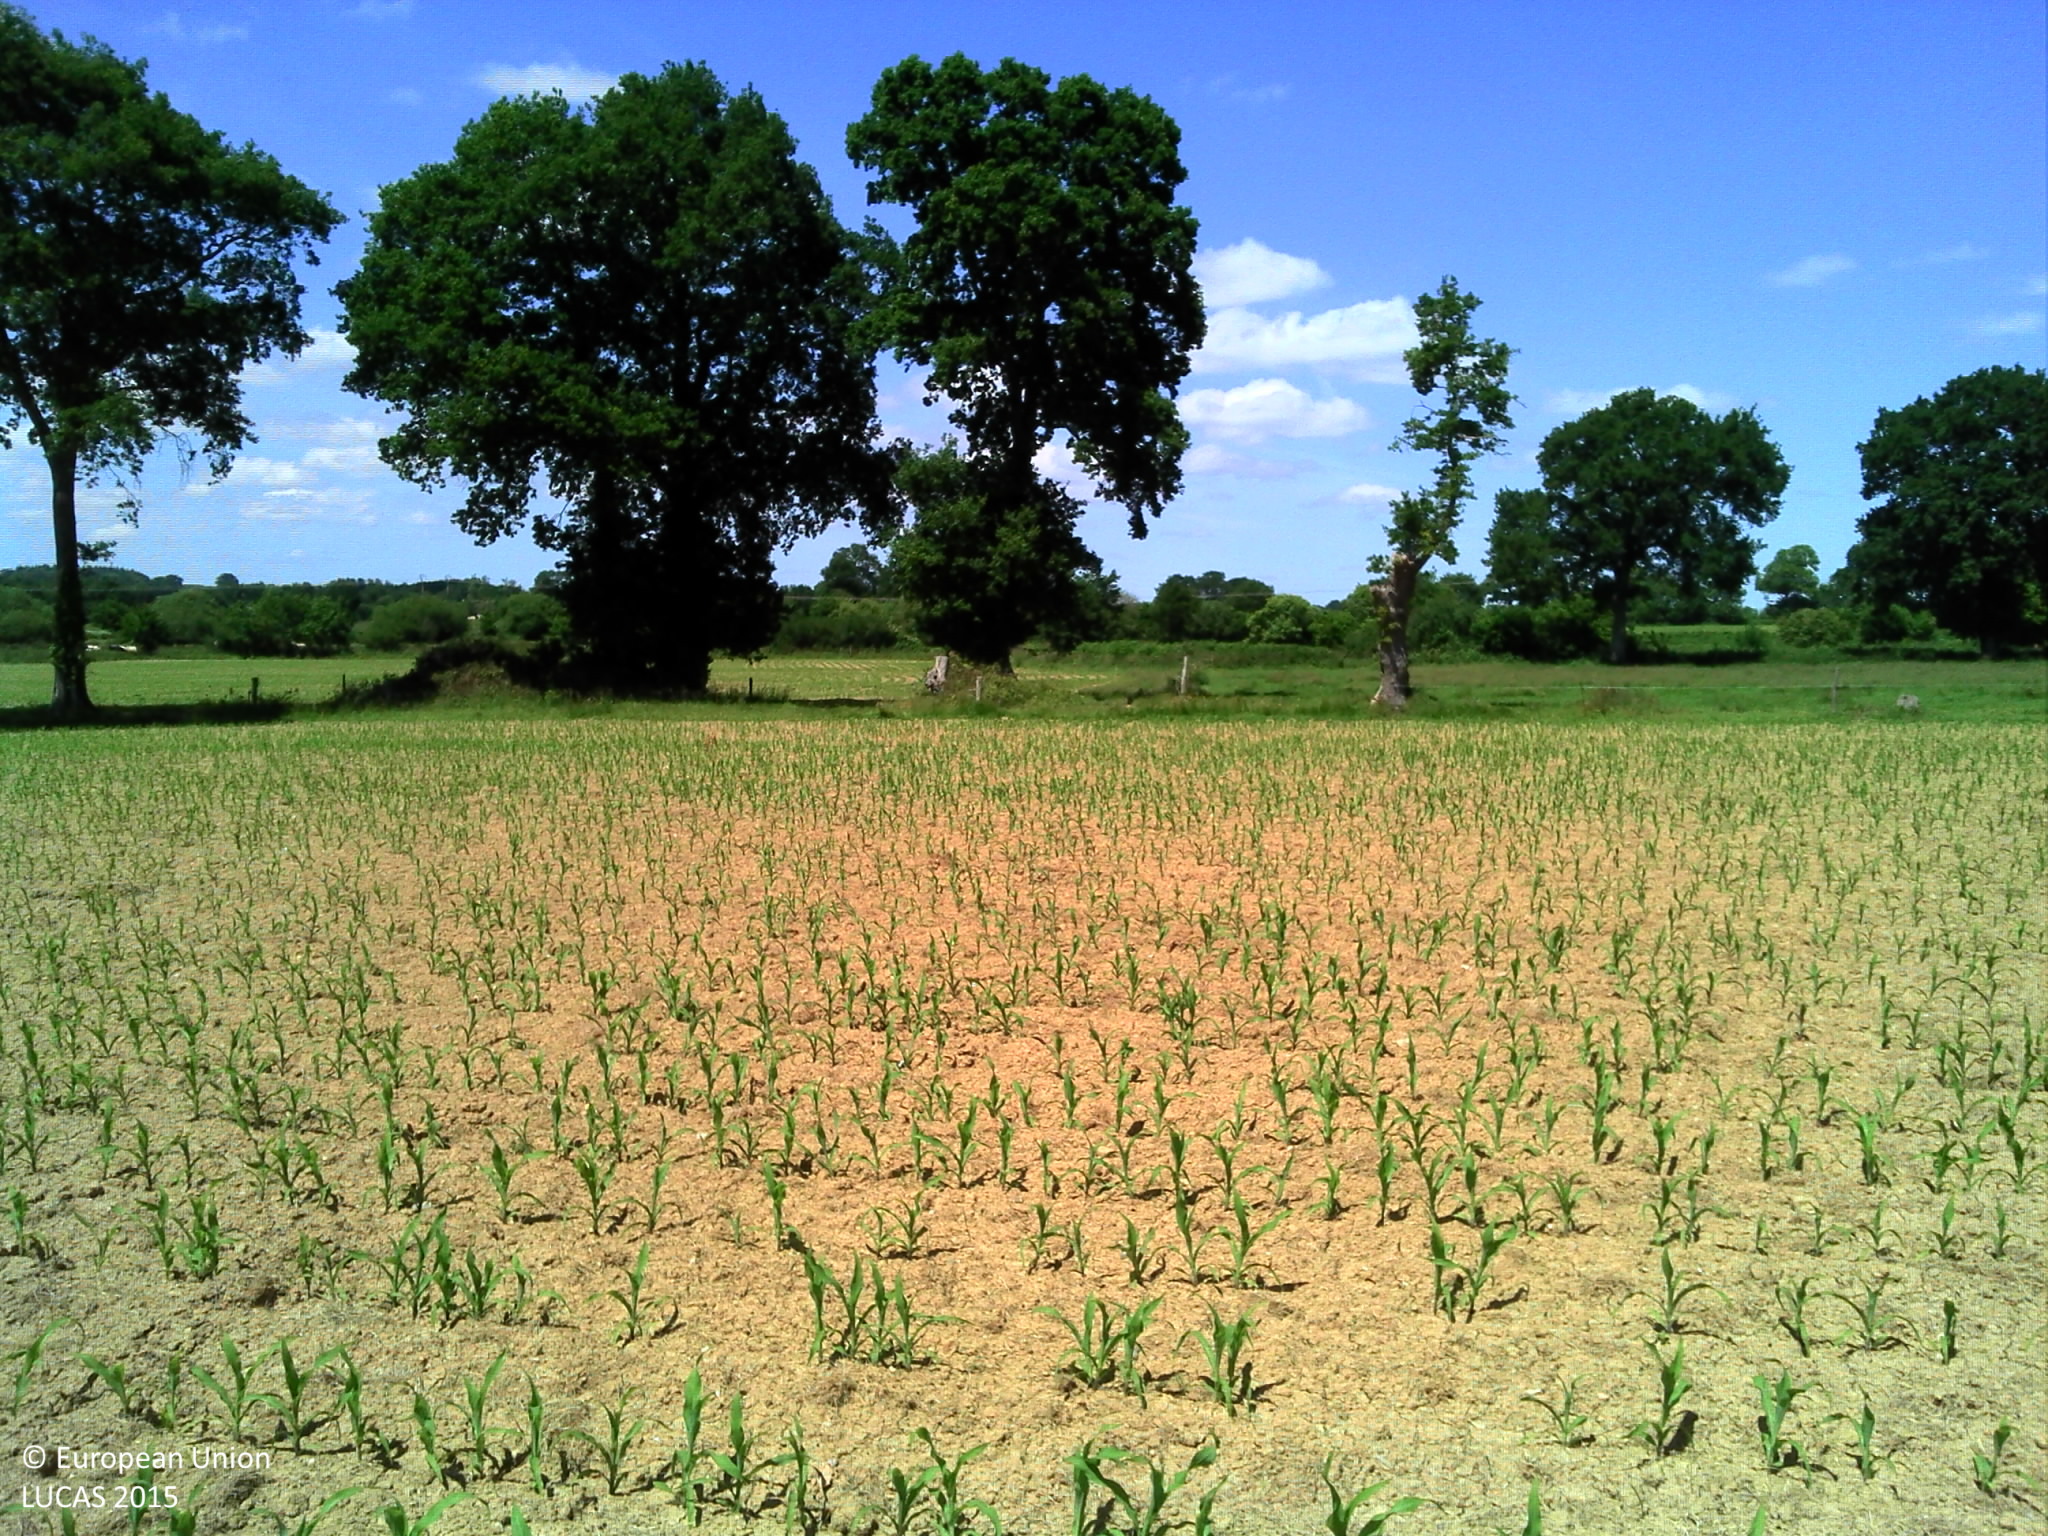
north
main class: Cropland
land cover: Maize
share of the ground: > 75 %
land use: Agriculture (excluding fallow land and kitchen gardens)
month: June
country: FR
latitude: 48.1305
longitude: -1.4798
